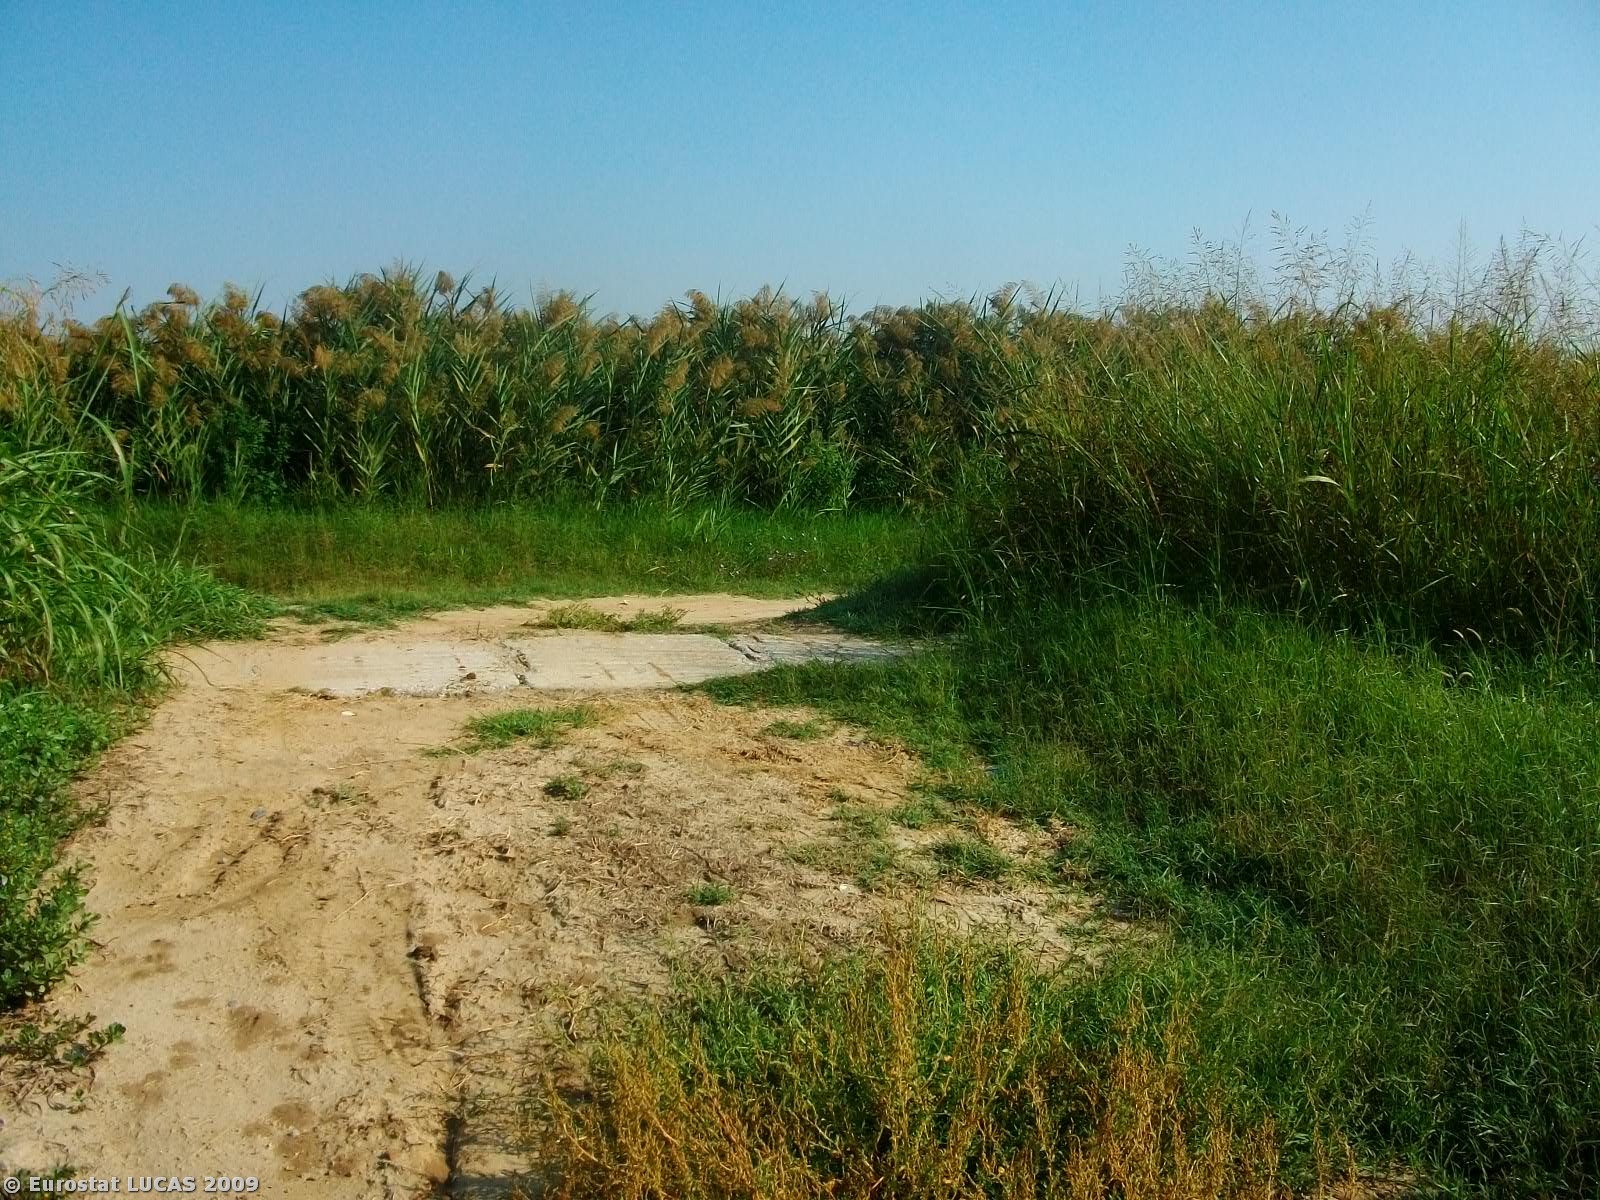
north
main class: Cropland
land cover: Rice
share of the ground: > 75 %
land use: Agriculture (excluding fallow land and kitchen gardens)
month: August
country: GR
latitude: 40.6935
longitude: 22.7507
